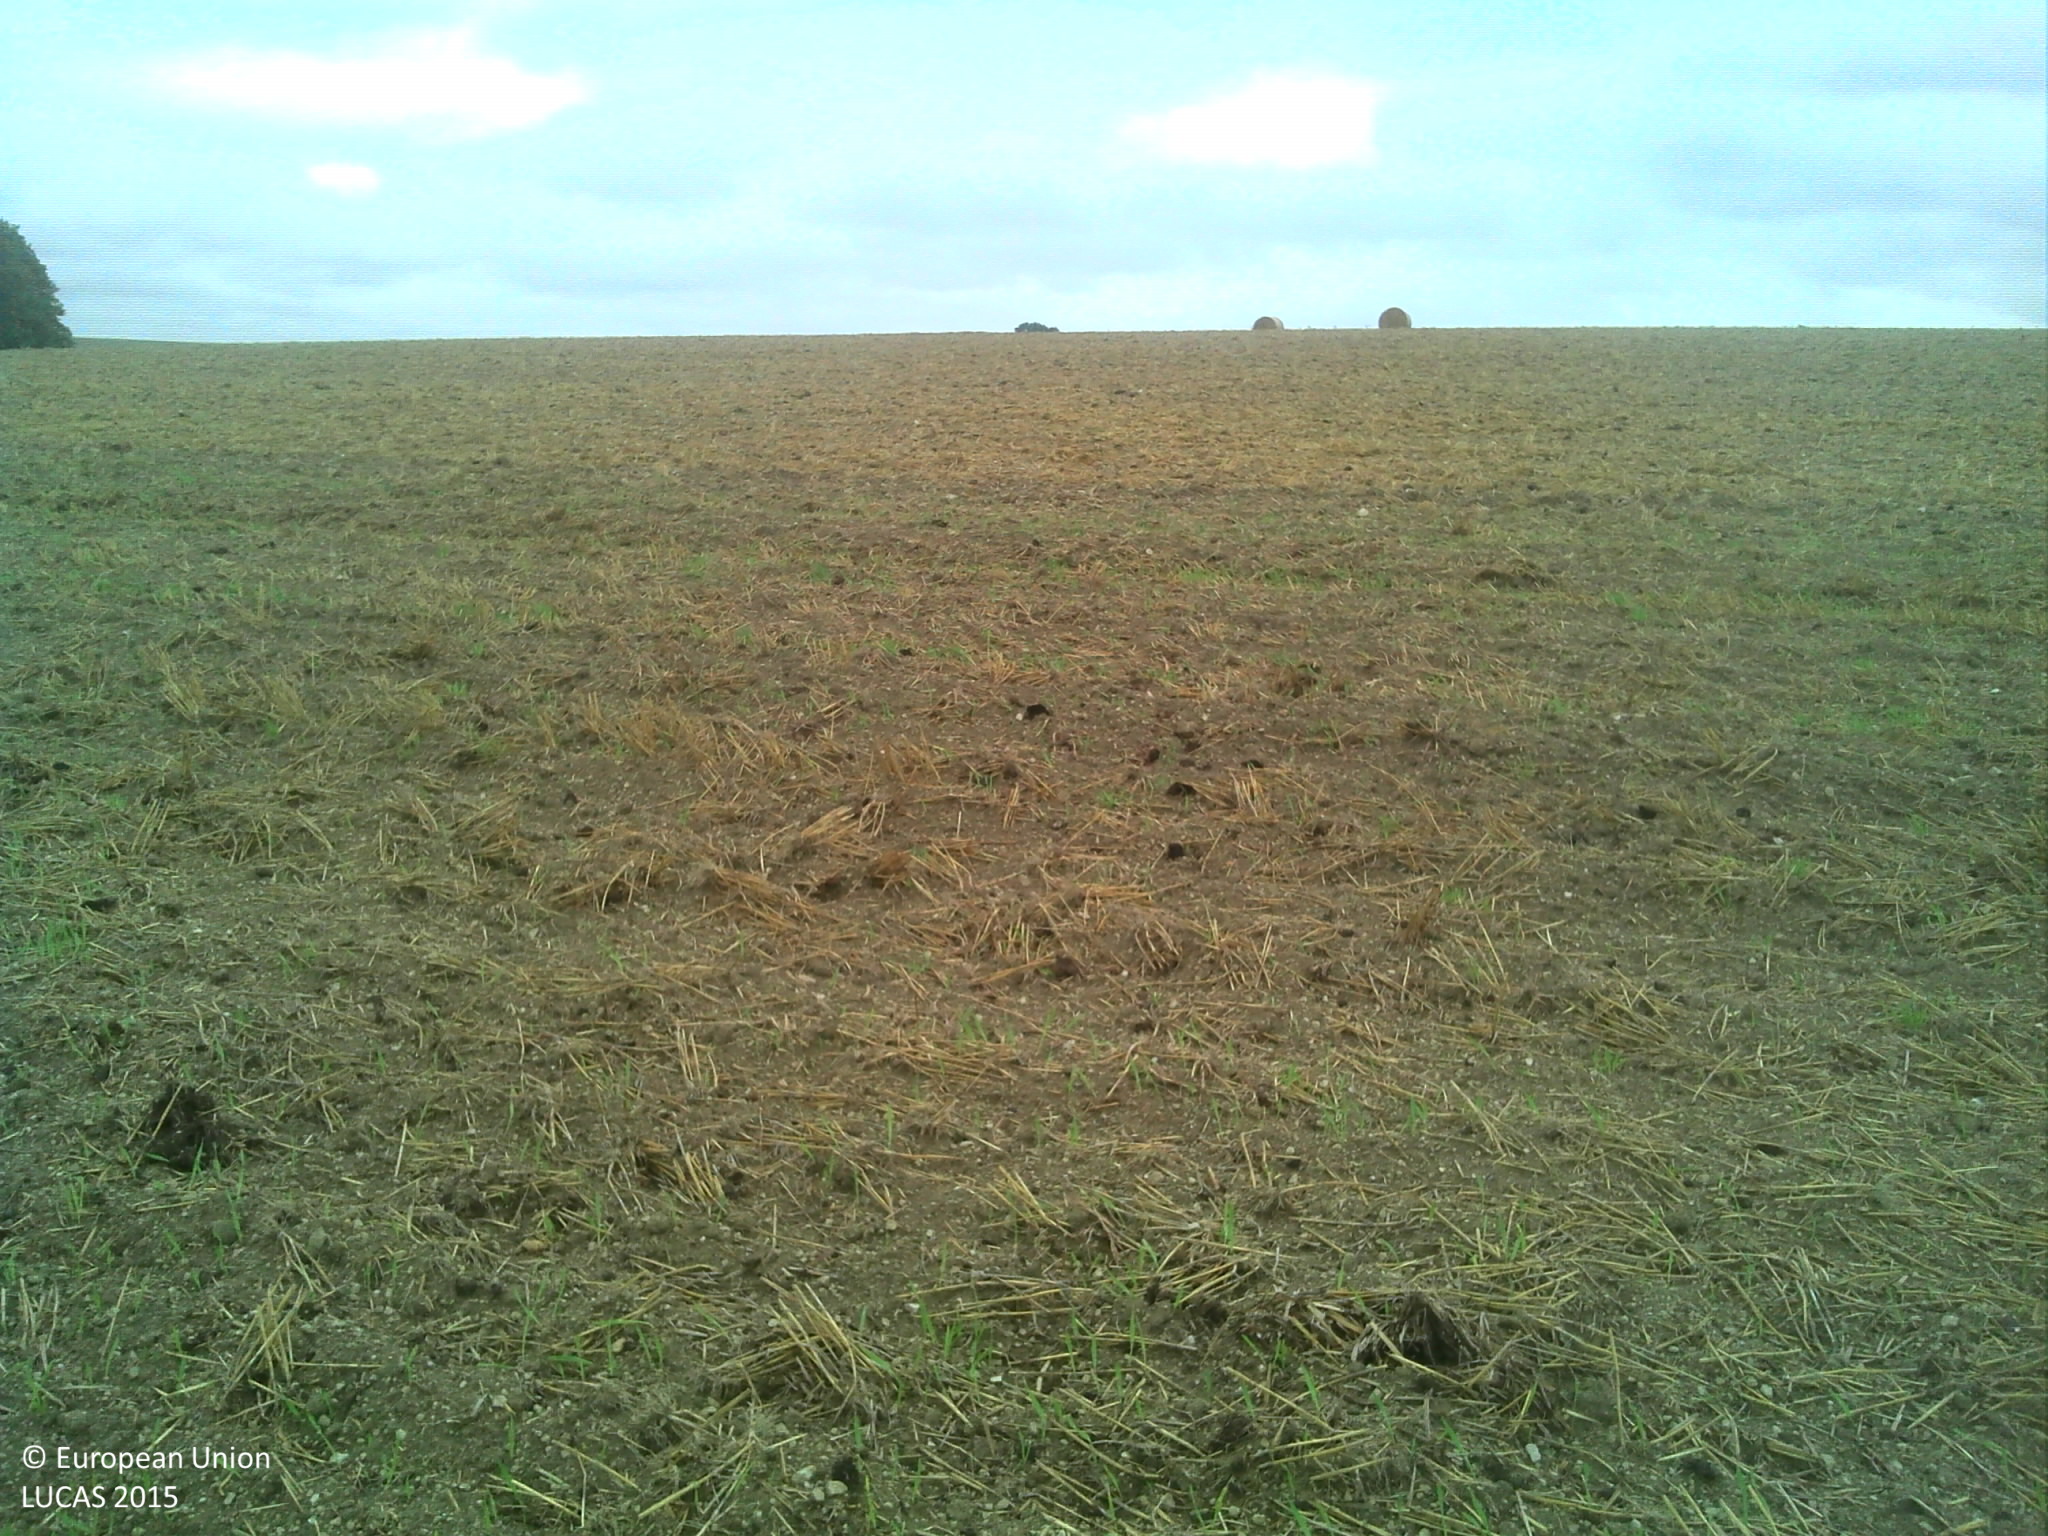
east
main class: Cropland
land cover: Barley
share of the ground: 25 - 50 %
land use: Agriculture (excluding fallow land and kitchen gardens)
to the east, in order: Barley; Common wheat; Barley
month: July
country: FR
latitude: 49.9127
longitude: 3.5730
